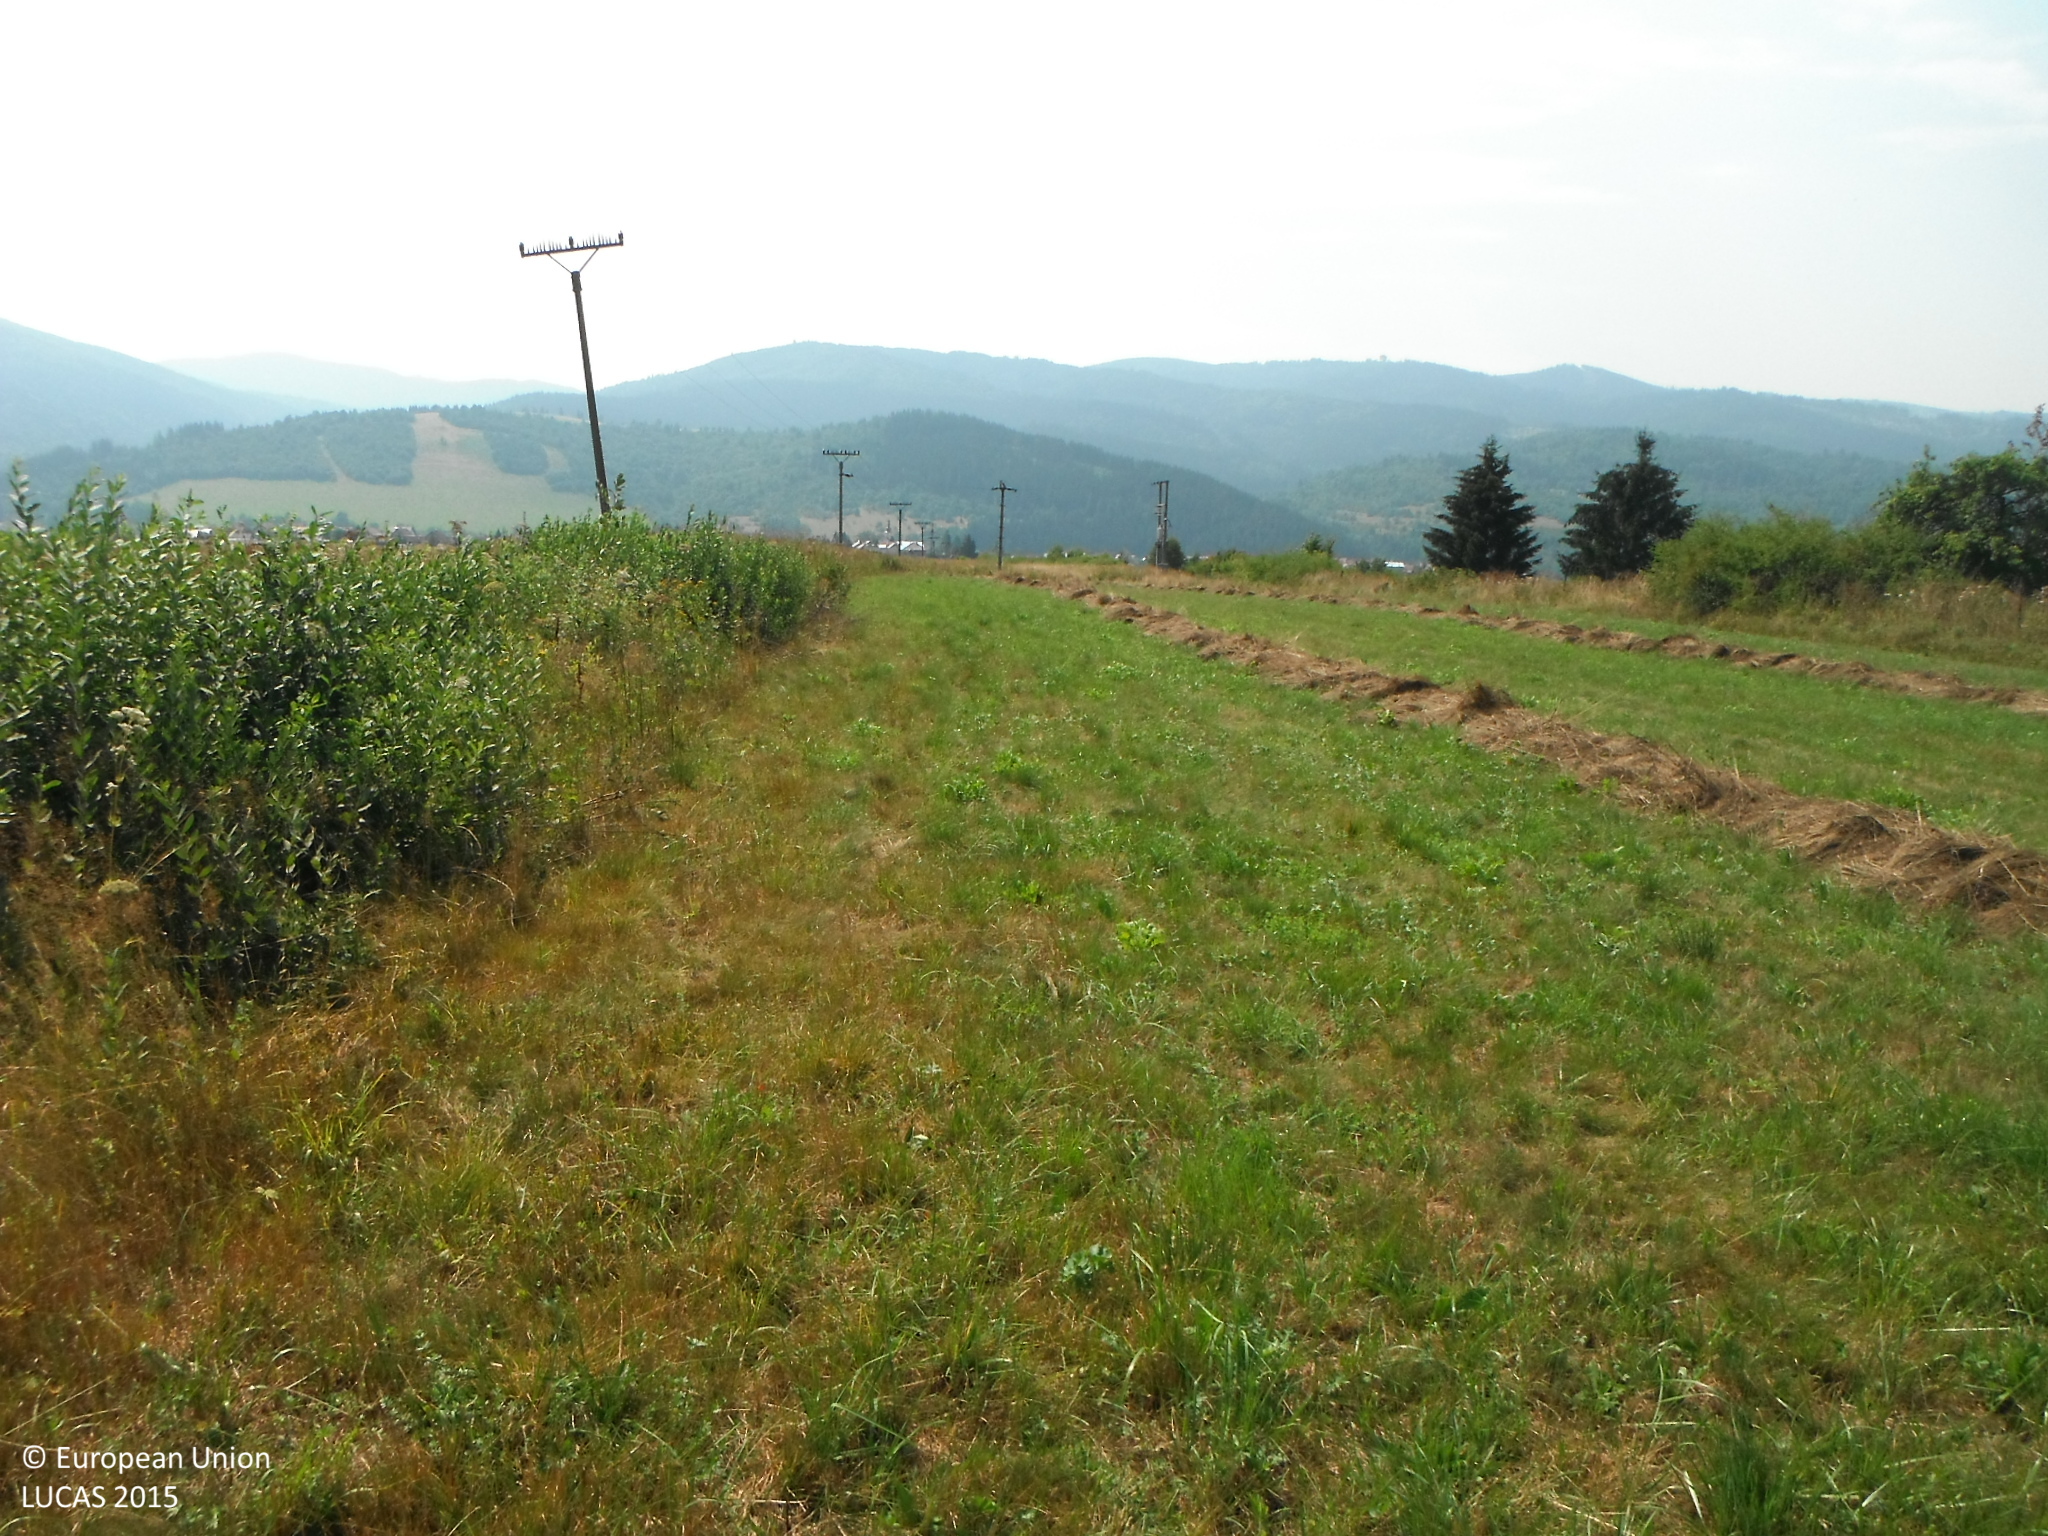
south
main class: Grassland
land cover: Grassland without tree/shrub cover
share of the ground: > 75 %
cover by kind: herbaceous plants 100 %
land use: Agriculture (excluding fallow land and kitchen gardens)
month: August
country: SK
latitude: 48.8633
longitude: 19.9124
